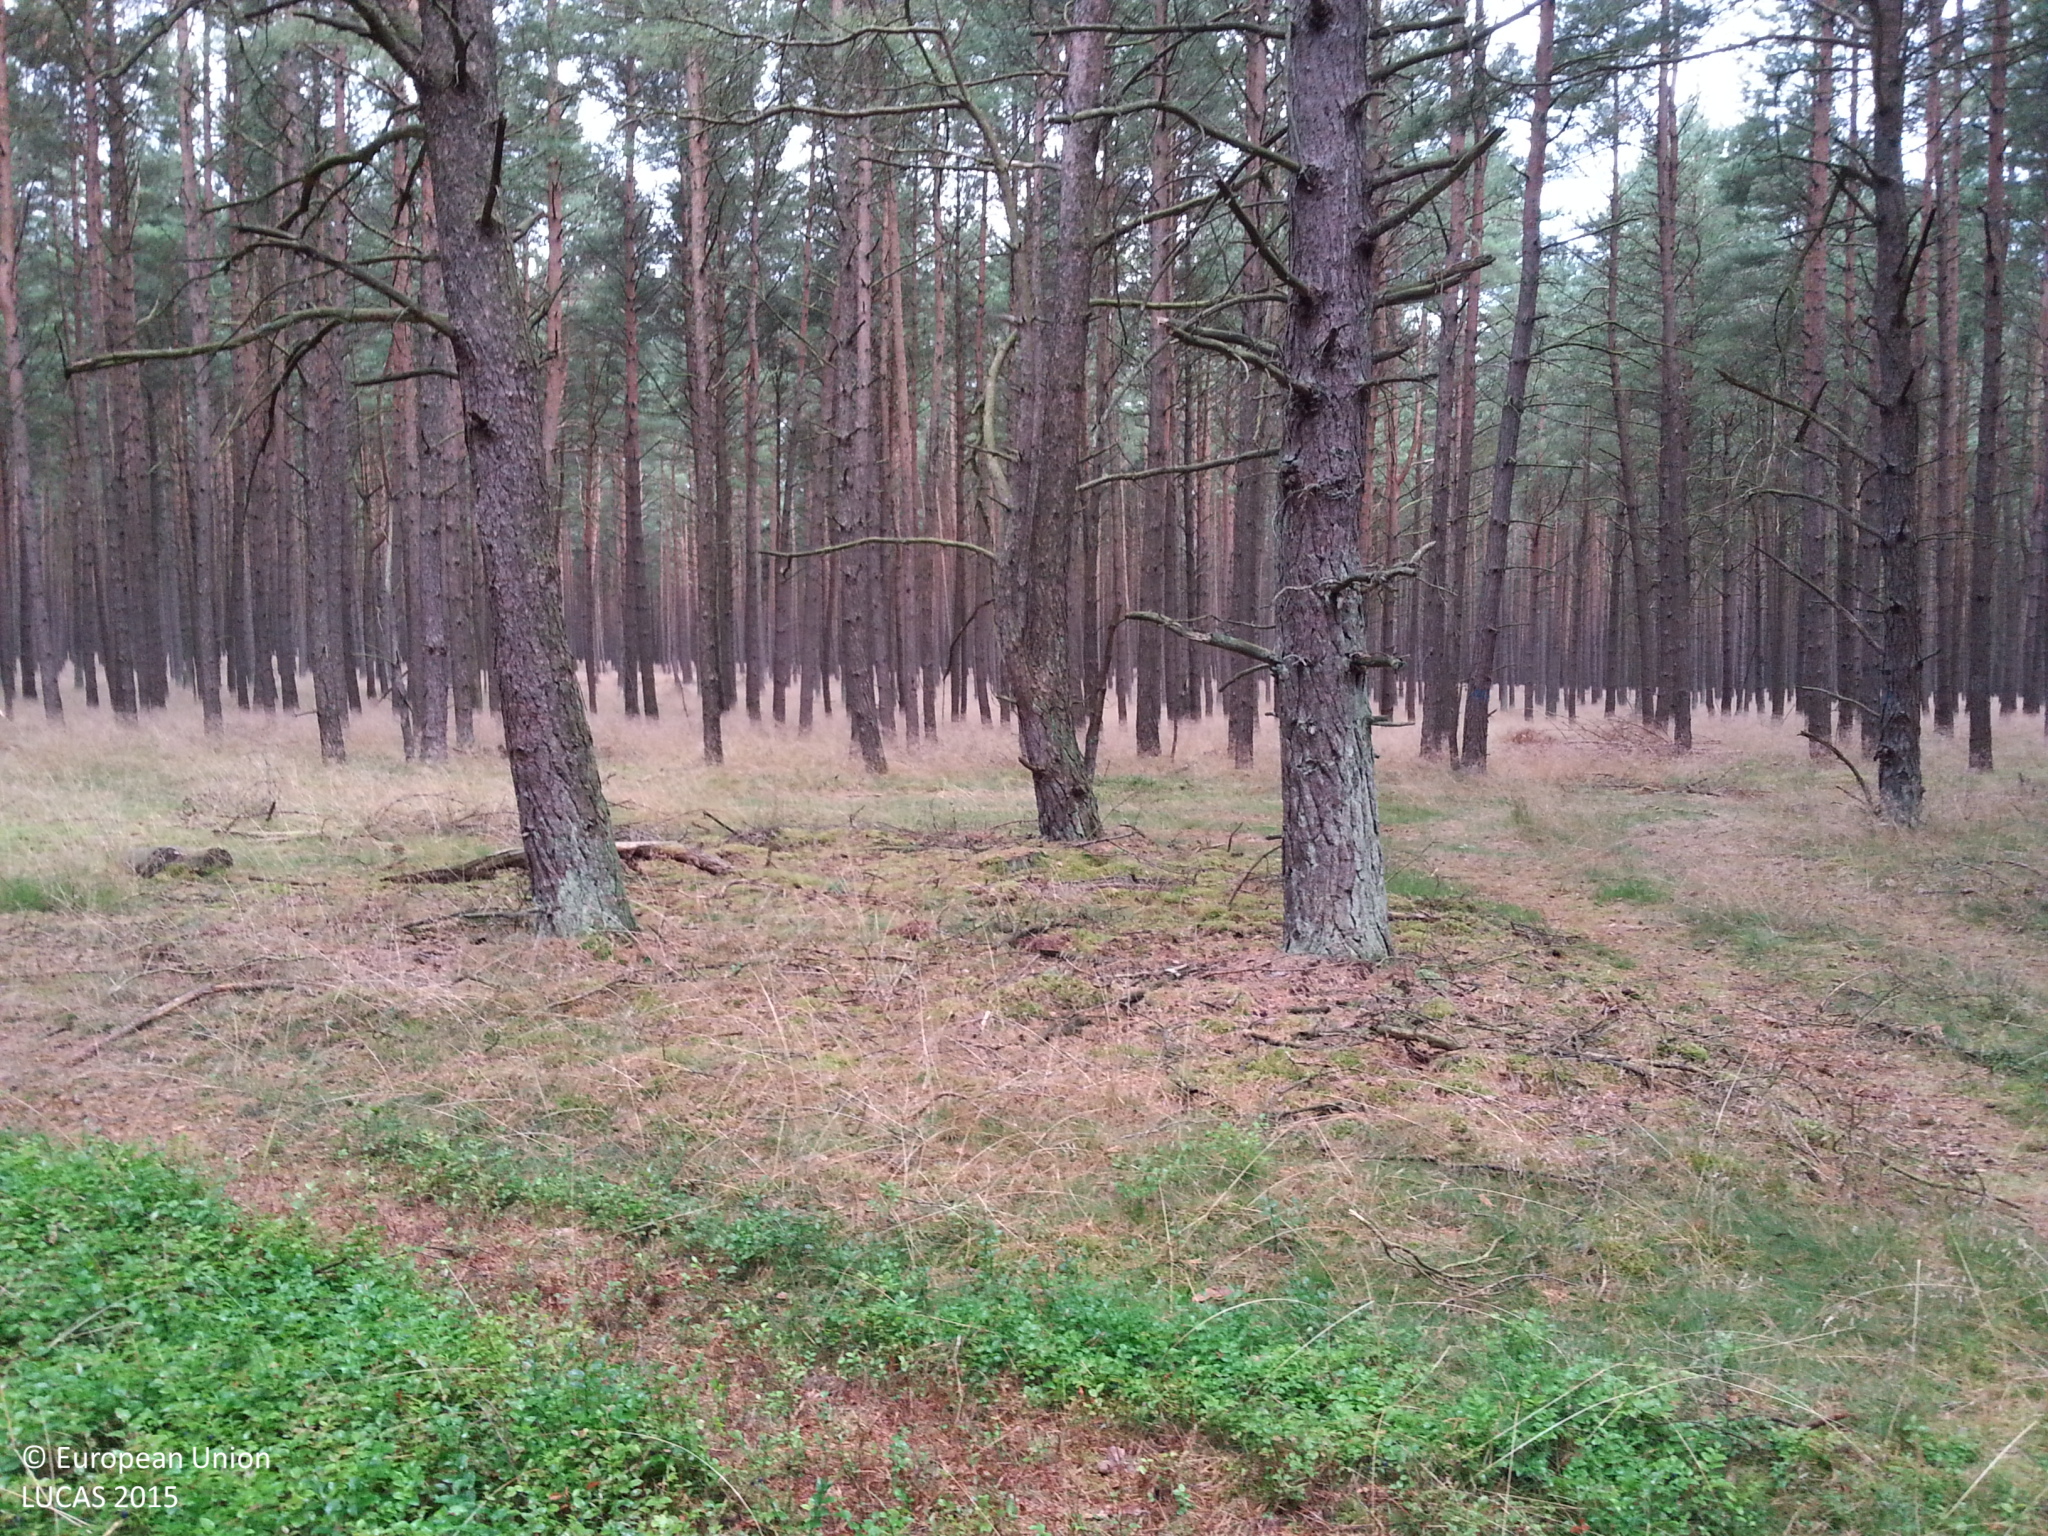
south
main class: Woodland
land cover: Pine dominated coniferous woodland
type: hemiboreal forest and nemoral coniferous forest and mixed broadleaved-coniferous forest
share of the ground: 50 - 75 %
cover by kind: coniferous forest trees 50 %, herbaceous plants 35 %, lichens and mosses 15 %
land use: Forestry
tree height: > 5 m
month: July
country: DE
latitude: 53.1095
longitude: 12.3447
